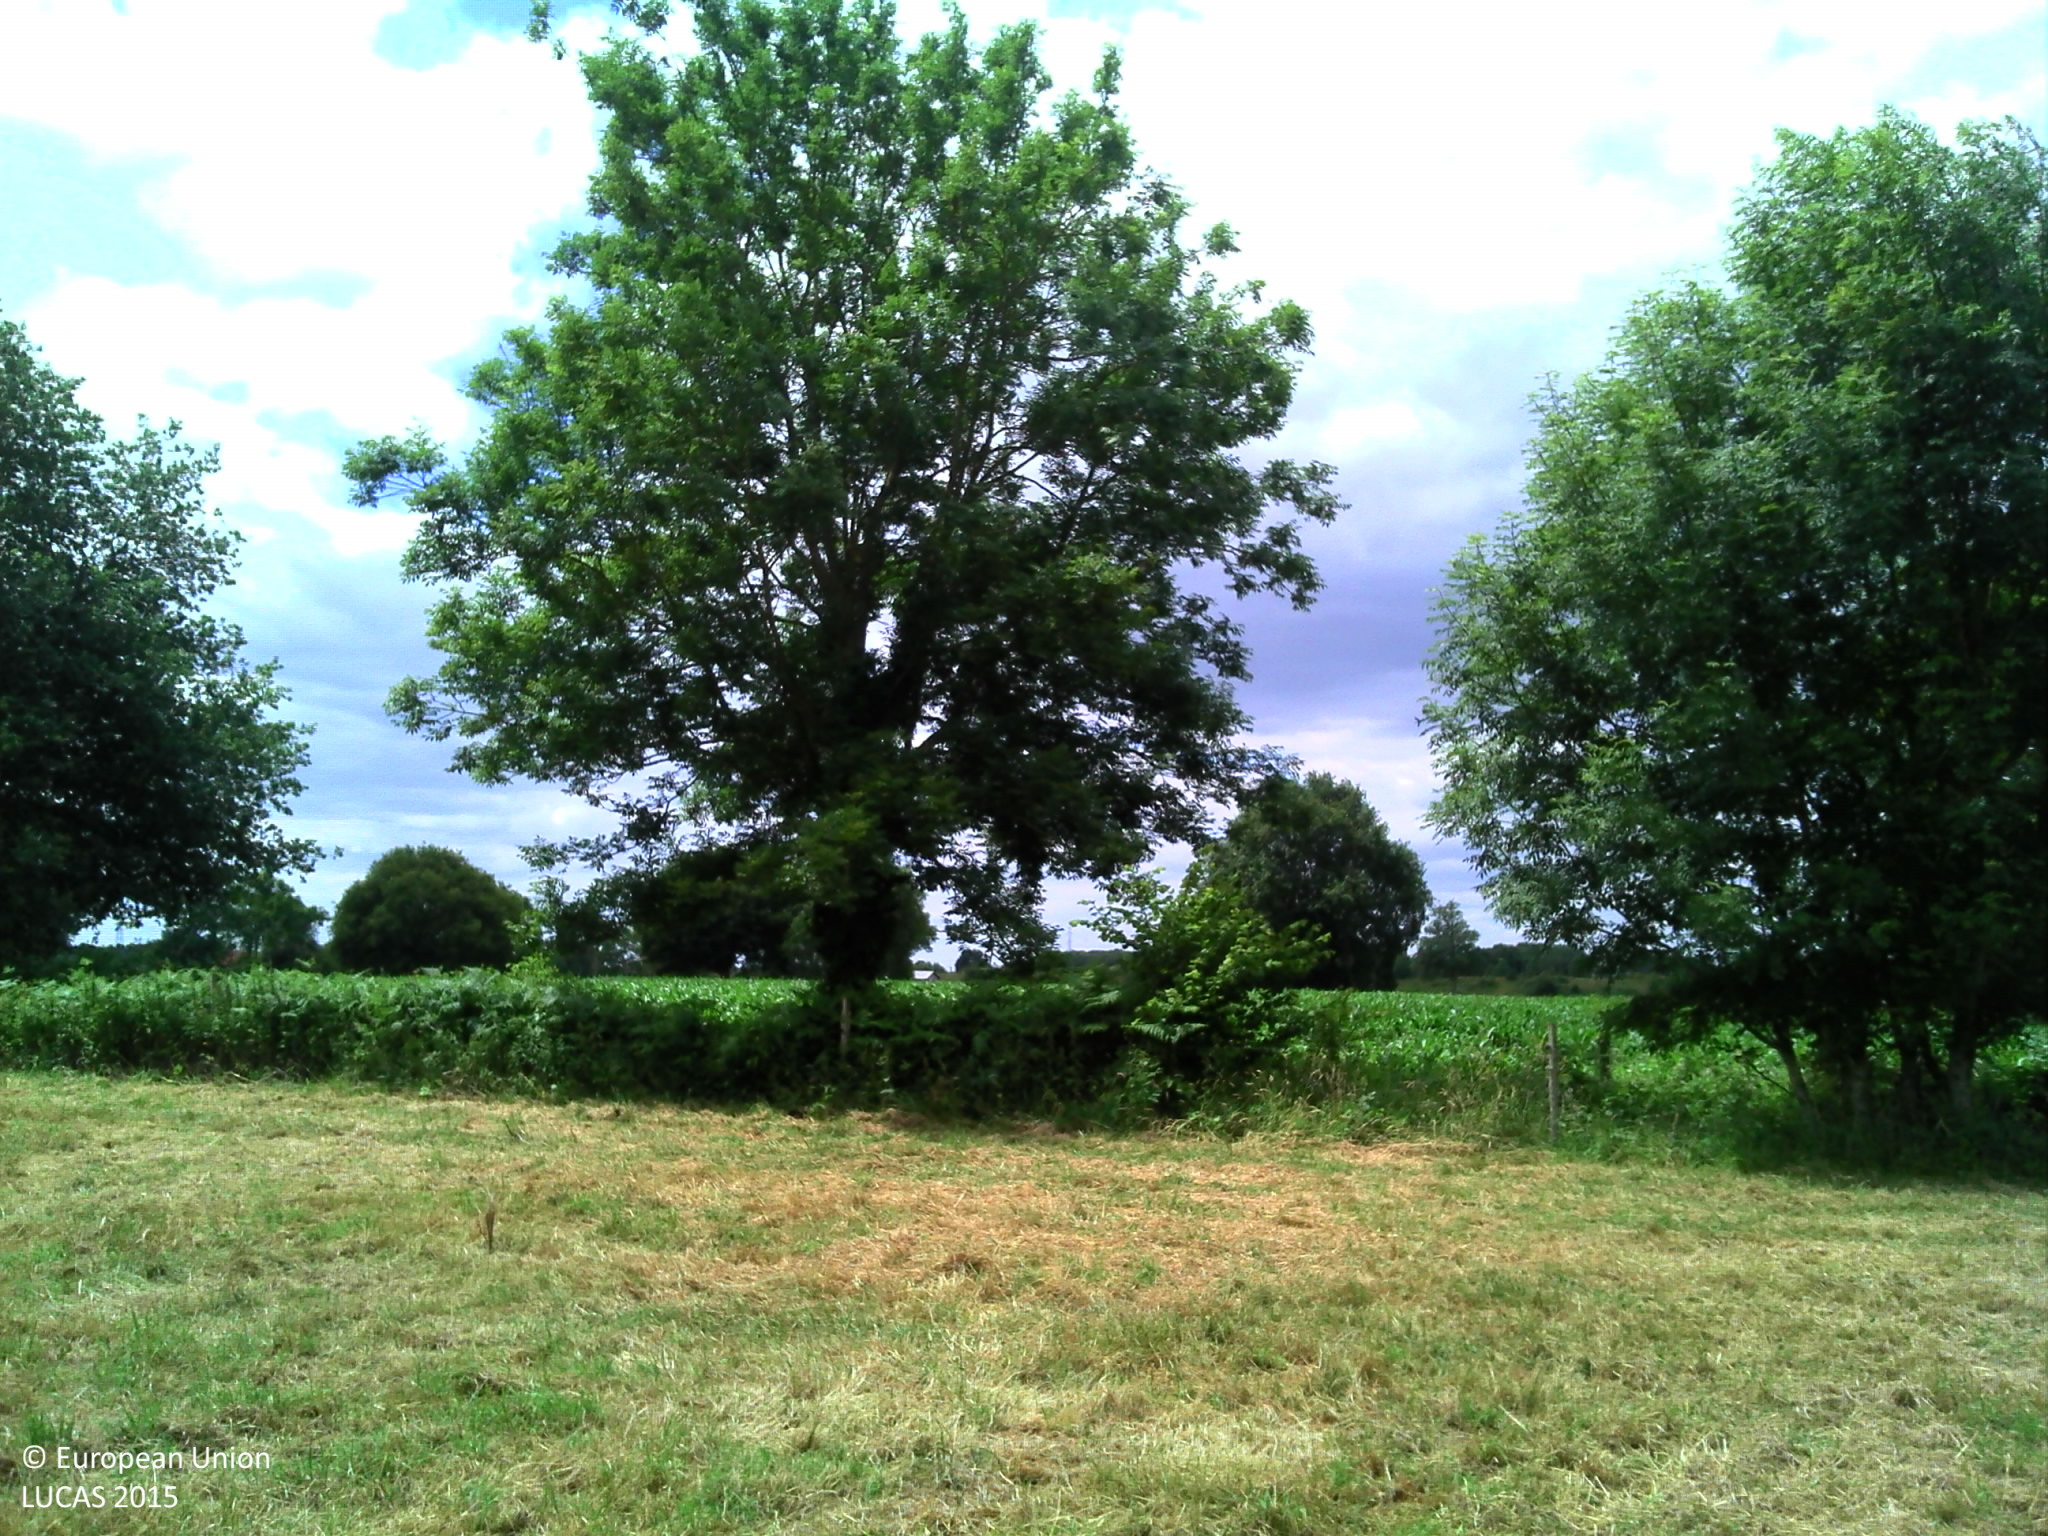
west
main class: Grassland
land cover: Grassland without tree/shrub cover
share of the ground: > 75 %
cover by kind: herbaceous plants 100 %
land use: Agriculture (excluding fallow land and kitchen gardens)
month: June
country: FR
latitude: 47.8682
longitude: 0.3099
